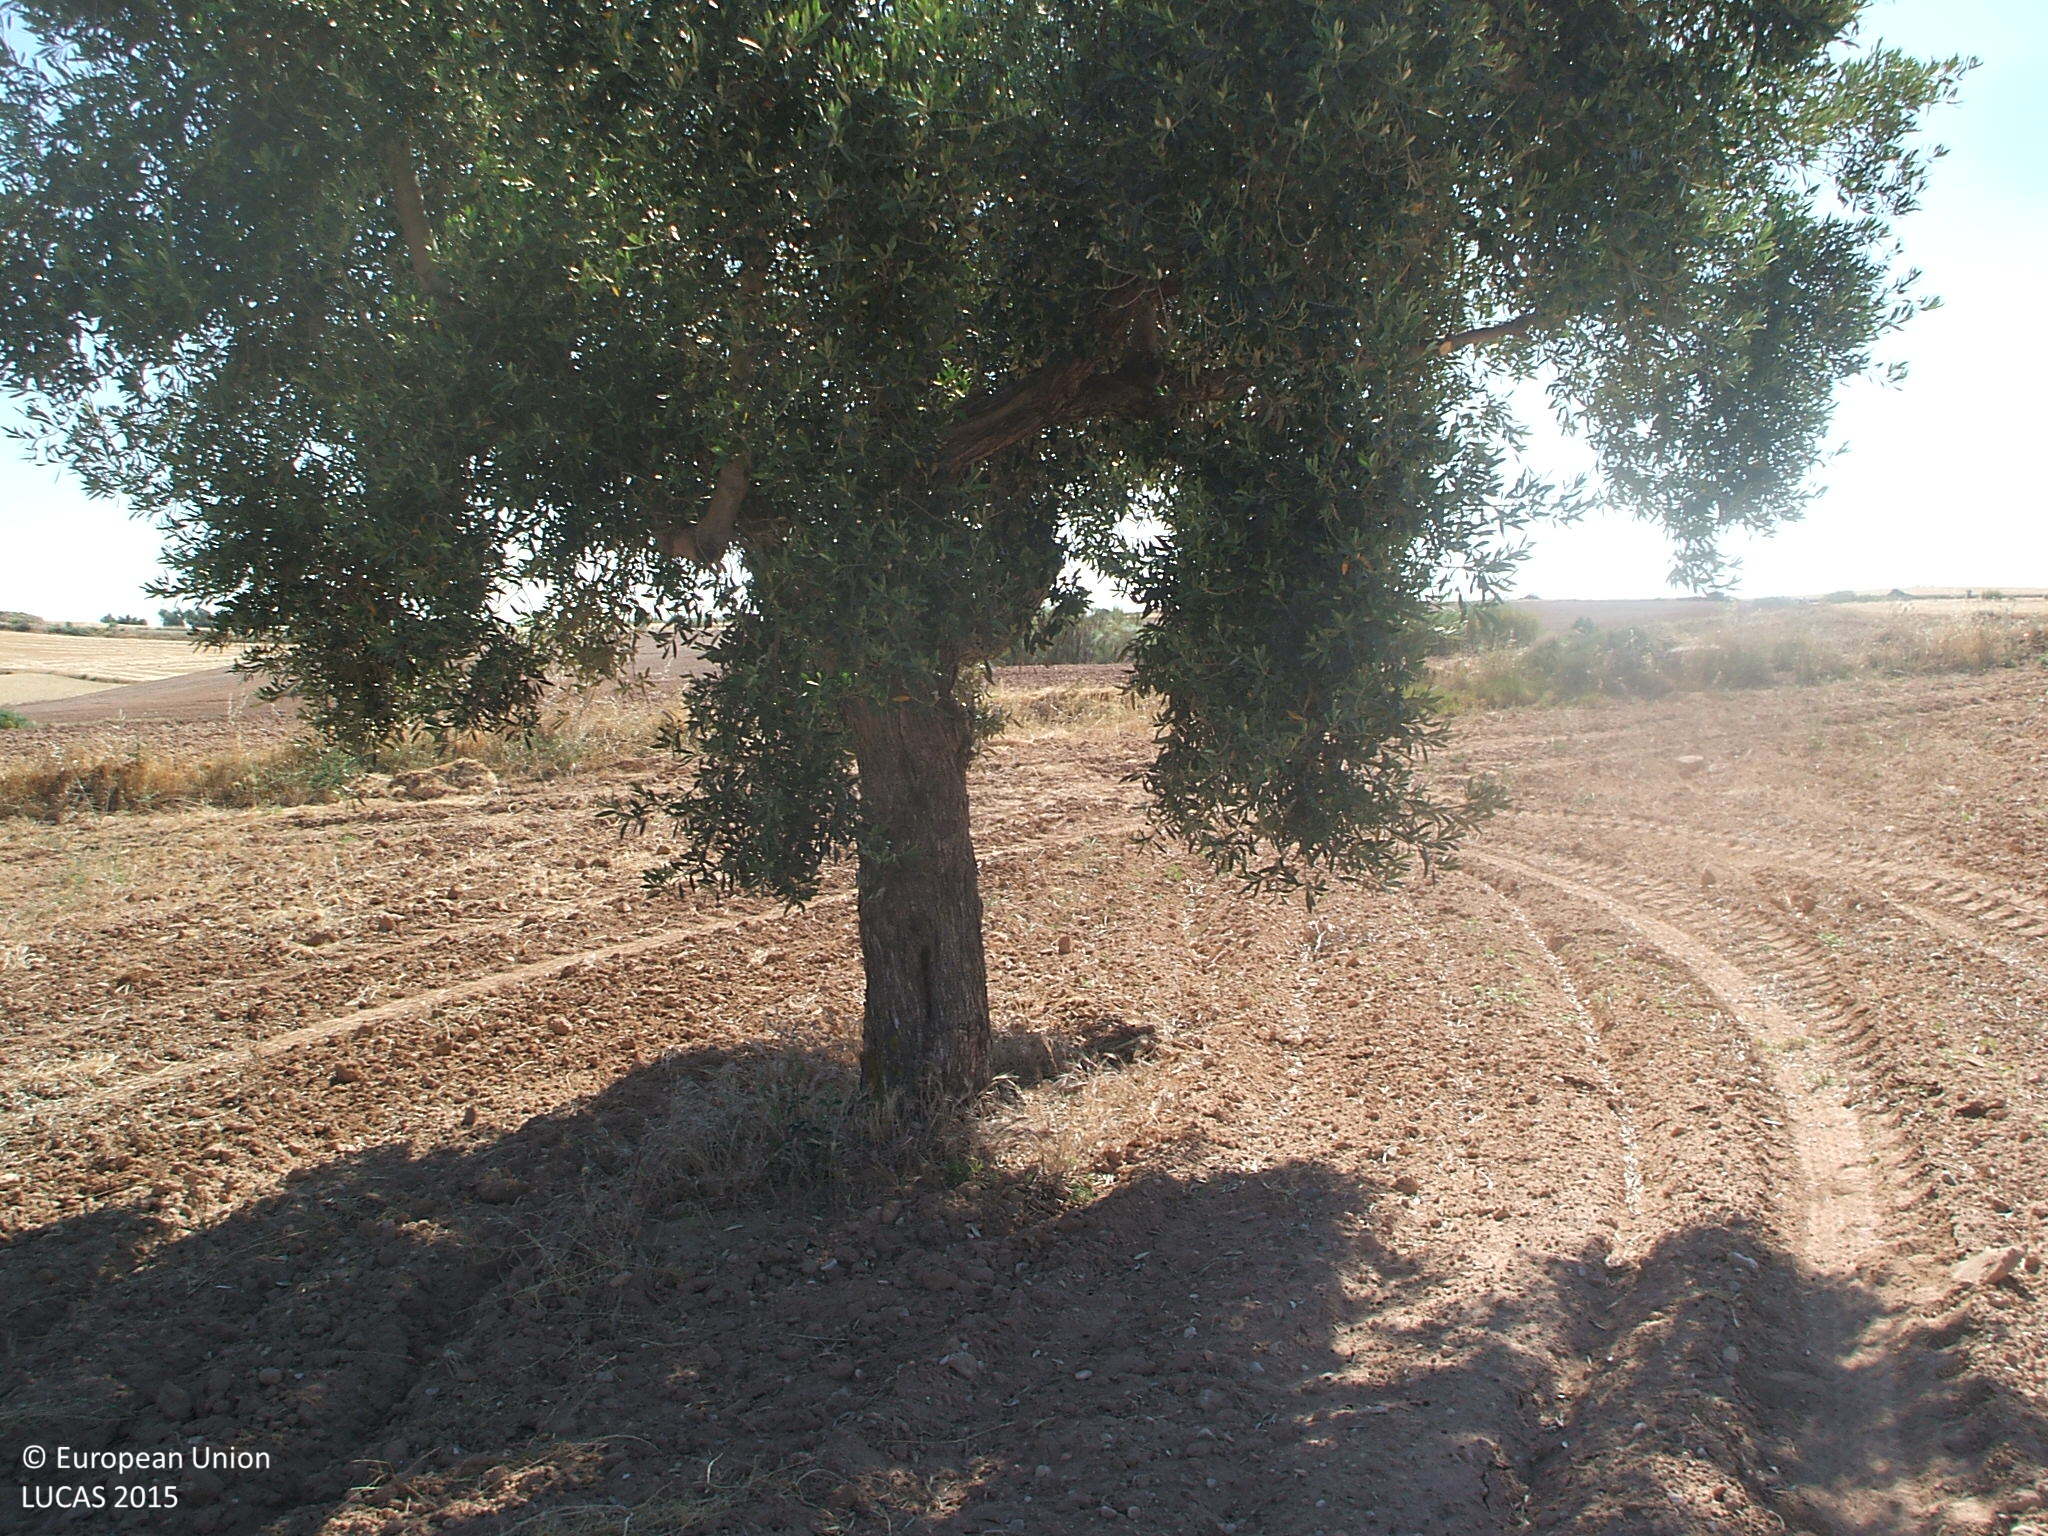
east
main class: Cropland
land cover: Olive groves
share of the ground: 25 - 50 %
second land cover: Other bare soil
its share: > 75 %
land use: Agriculture (excluding fallow land and kitchen gardens)
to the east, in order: Olive groves; Other bare soil; Olive groves; Grass margins; Other bare soil; Shruby margins; Spontaneously vegetated surfaces; Grass margins; Other bare soil; Shruby margins; Other bare soil; Grass margins; Other bare soil
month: June
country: ES
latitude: 41.0354
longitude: -0.3013
